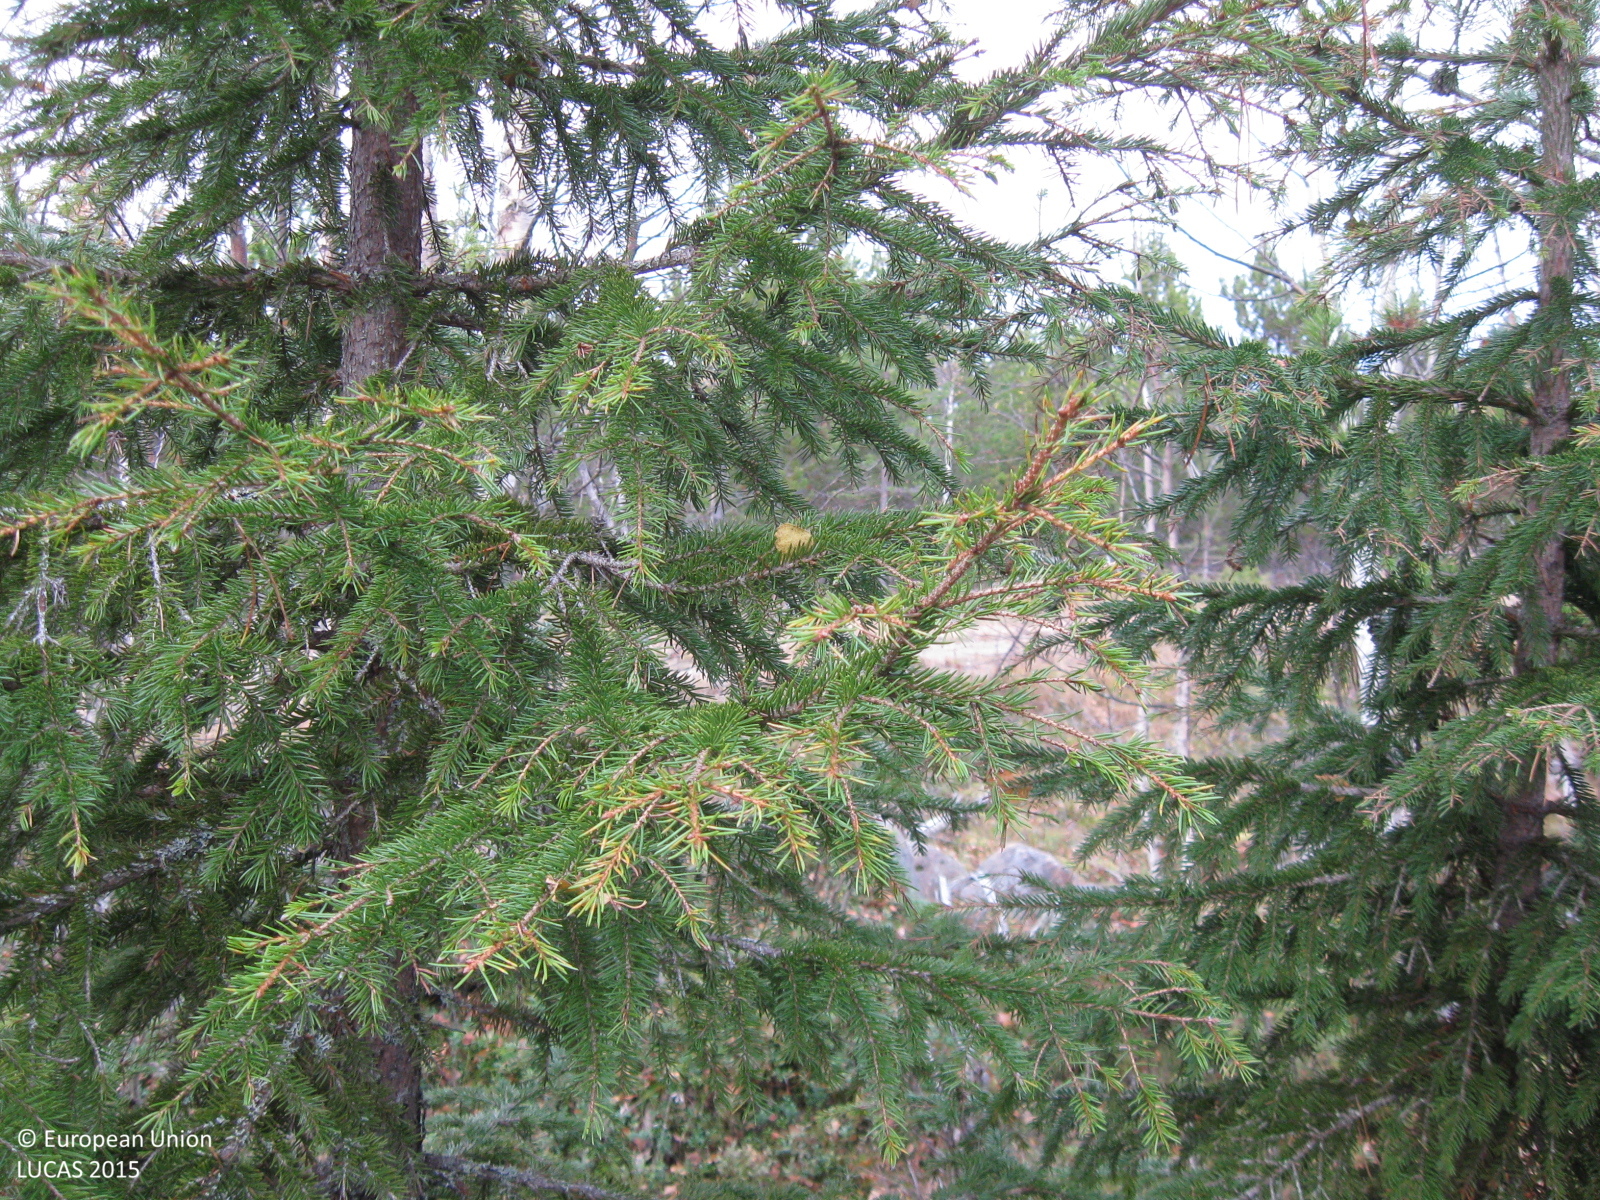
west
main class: Woodland
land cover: Pine dominated coniferous woodland
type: exotic forest
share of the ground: > 75 %
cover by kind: coniferous forest trees 80 %, broadleaved forest trees 5 %, herbaceous plants 5 %, lichens and mosses 5 %, unconsolidated bare surface 5 %
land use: Forestry
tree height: > 5 m
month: October
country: SE
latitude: 66.1070
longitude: 22.2094
